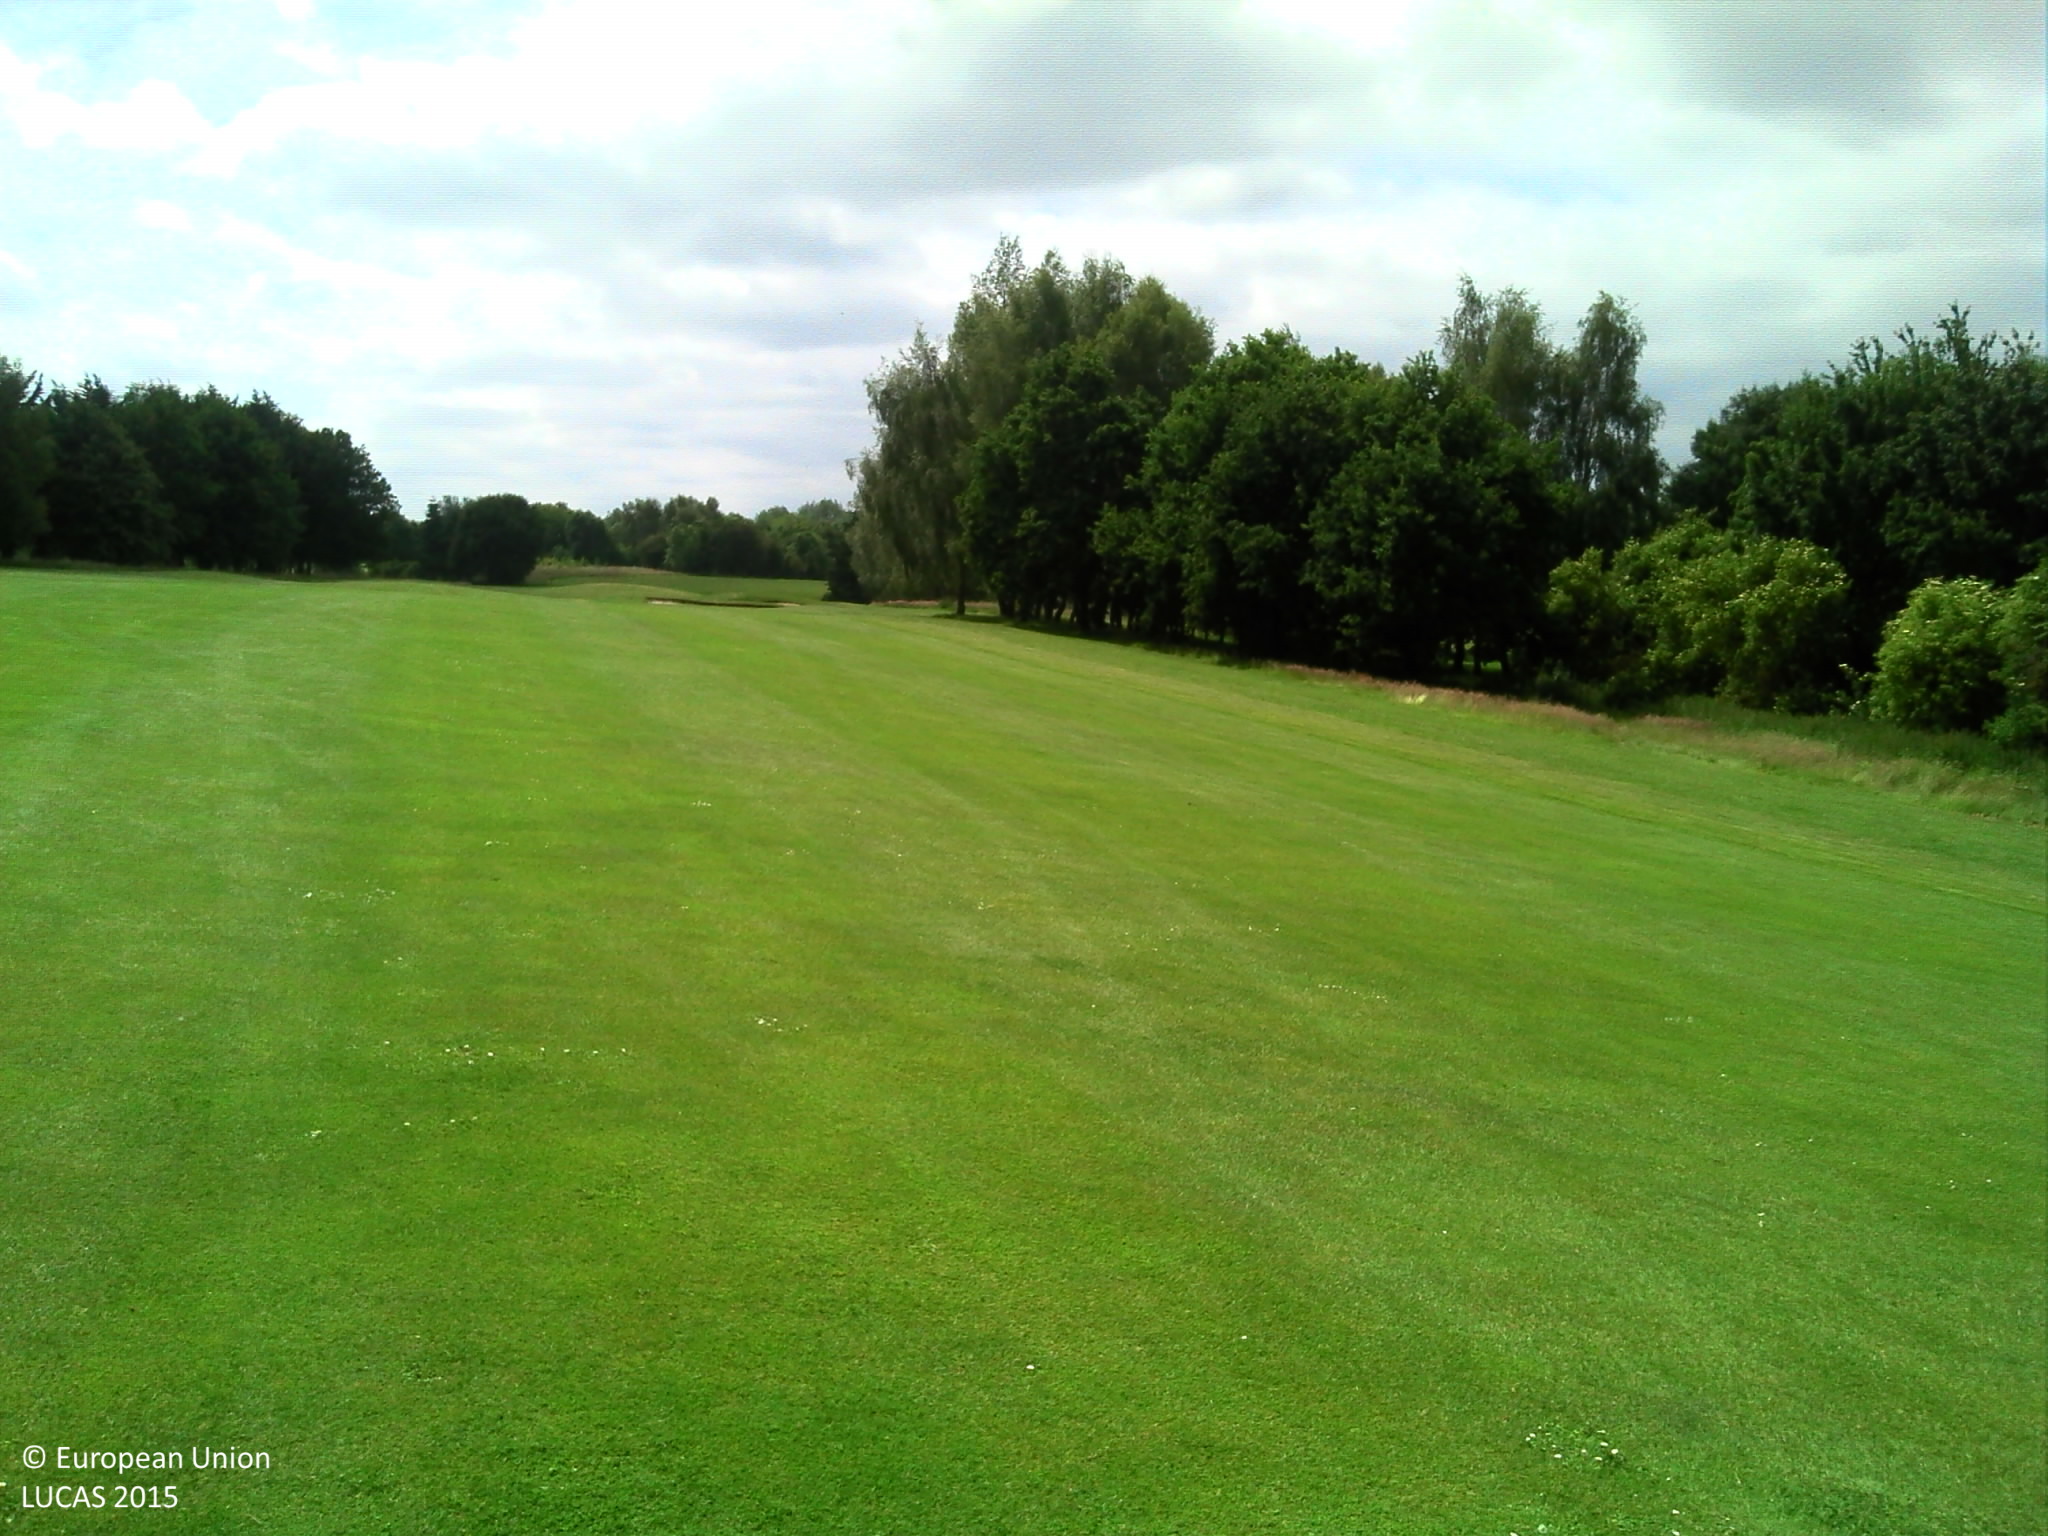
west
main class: Grassland
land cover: Grassland without tree/shrub cover
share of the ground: > 75 %
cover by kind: herbaceous plants 100 %
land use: Sport
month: June
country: FR
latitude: 49.2227
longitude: -0.3462
